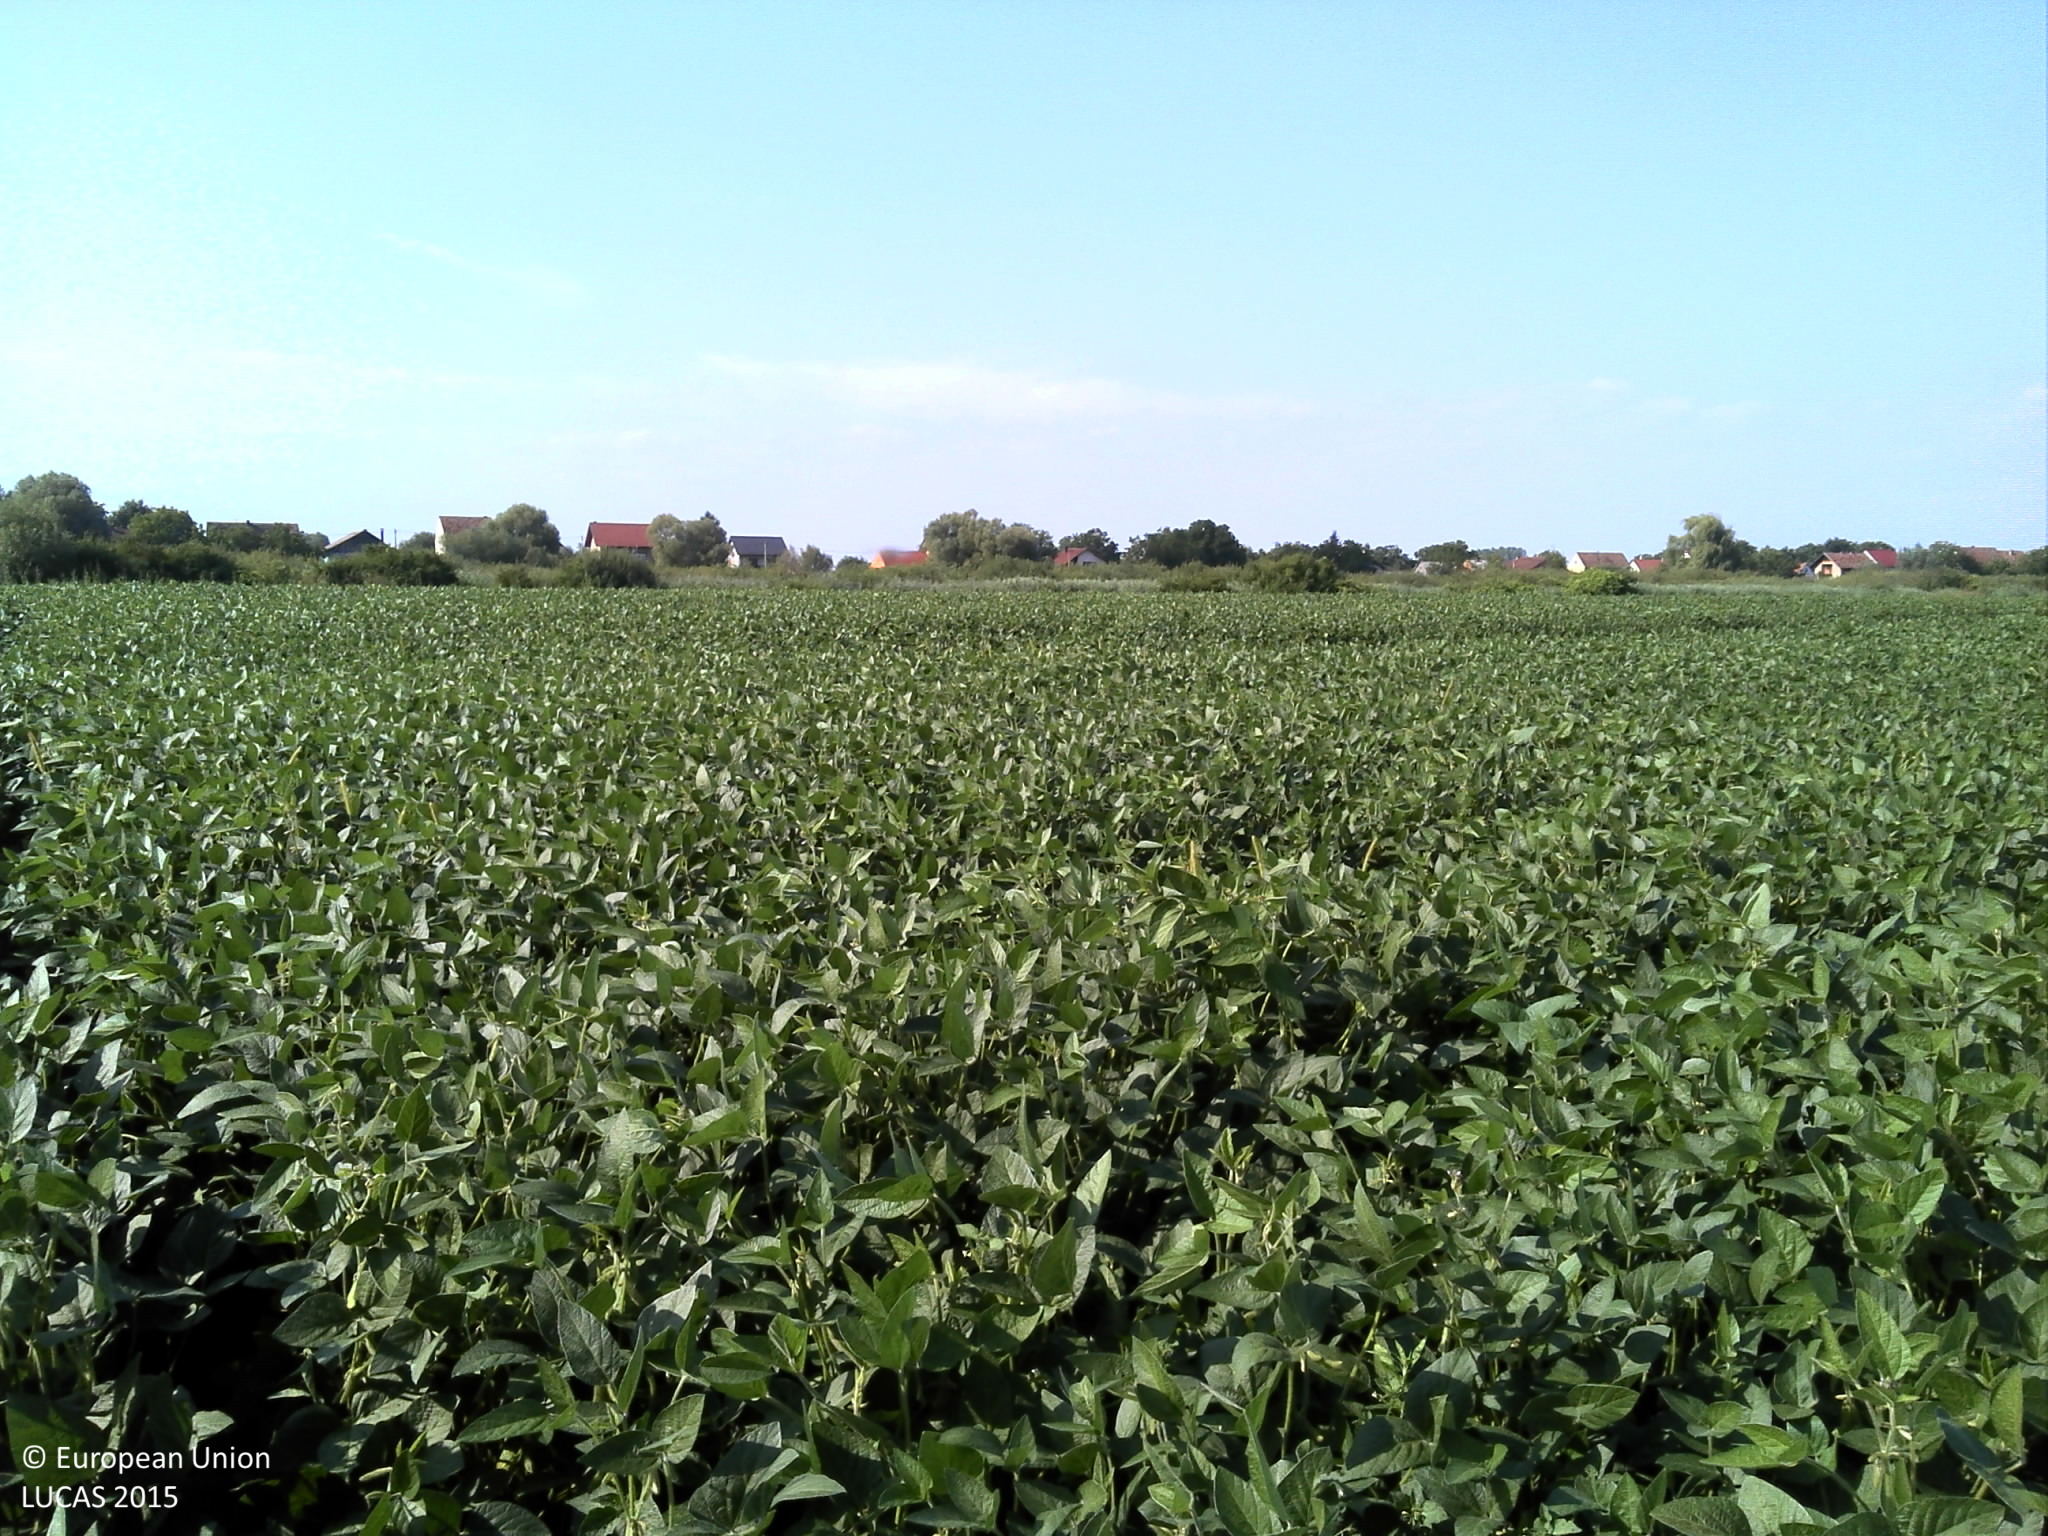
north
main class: Cropland
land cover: Soya
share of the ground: > 75 %
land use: Agriculture (excluding fallow land and kitchen gardens)
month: August
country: HR
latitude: 45.4709
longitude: 16.4318
